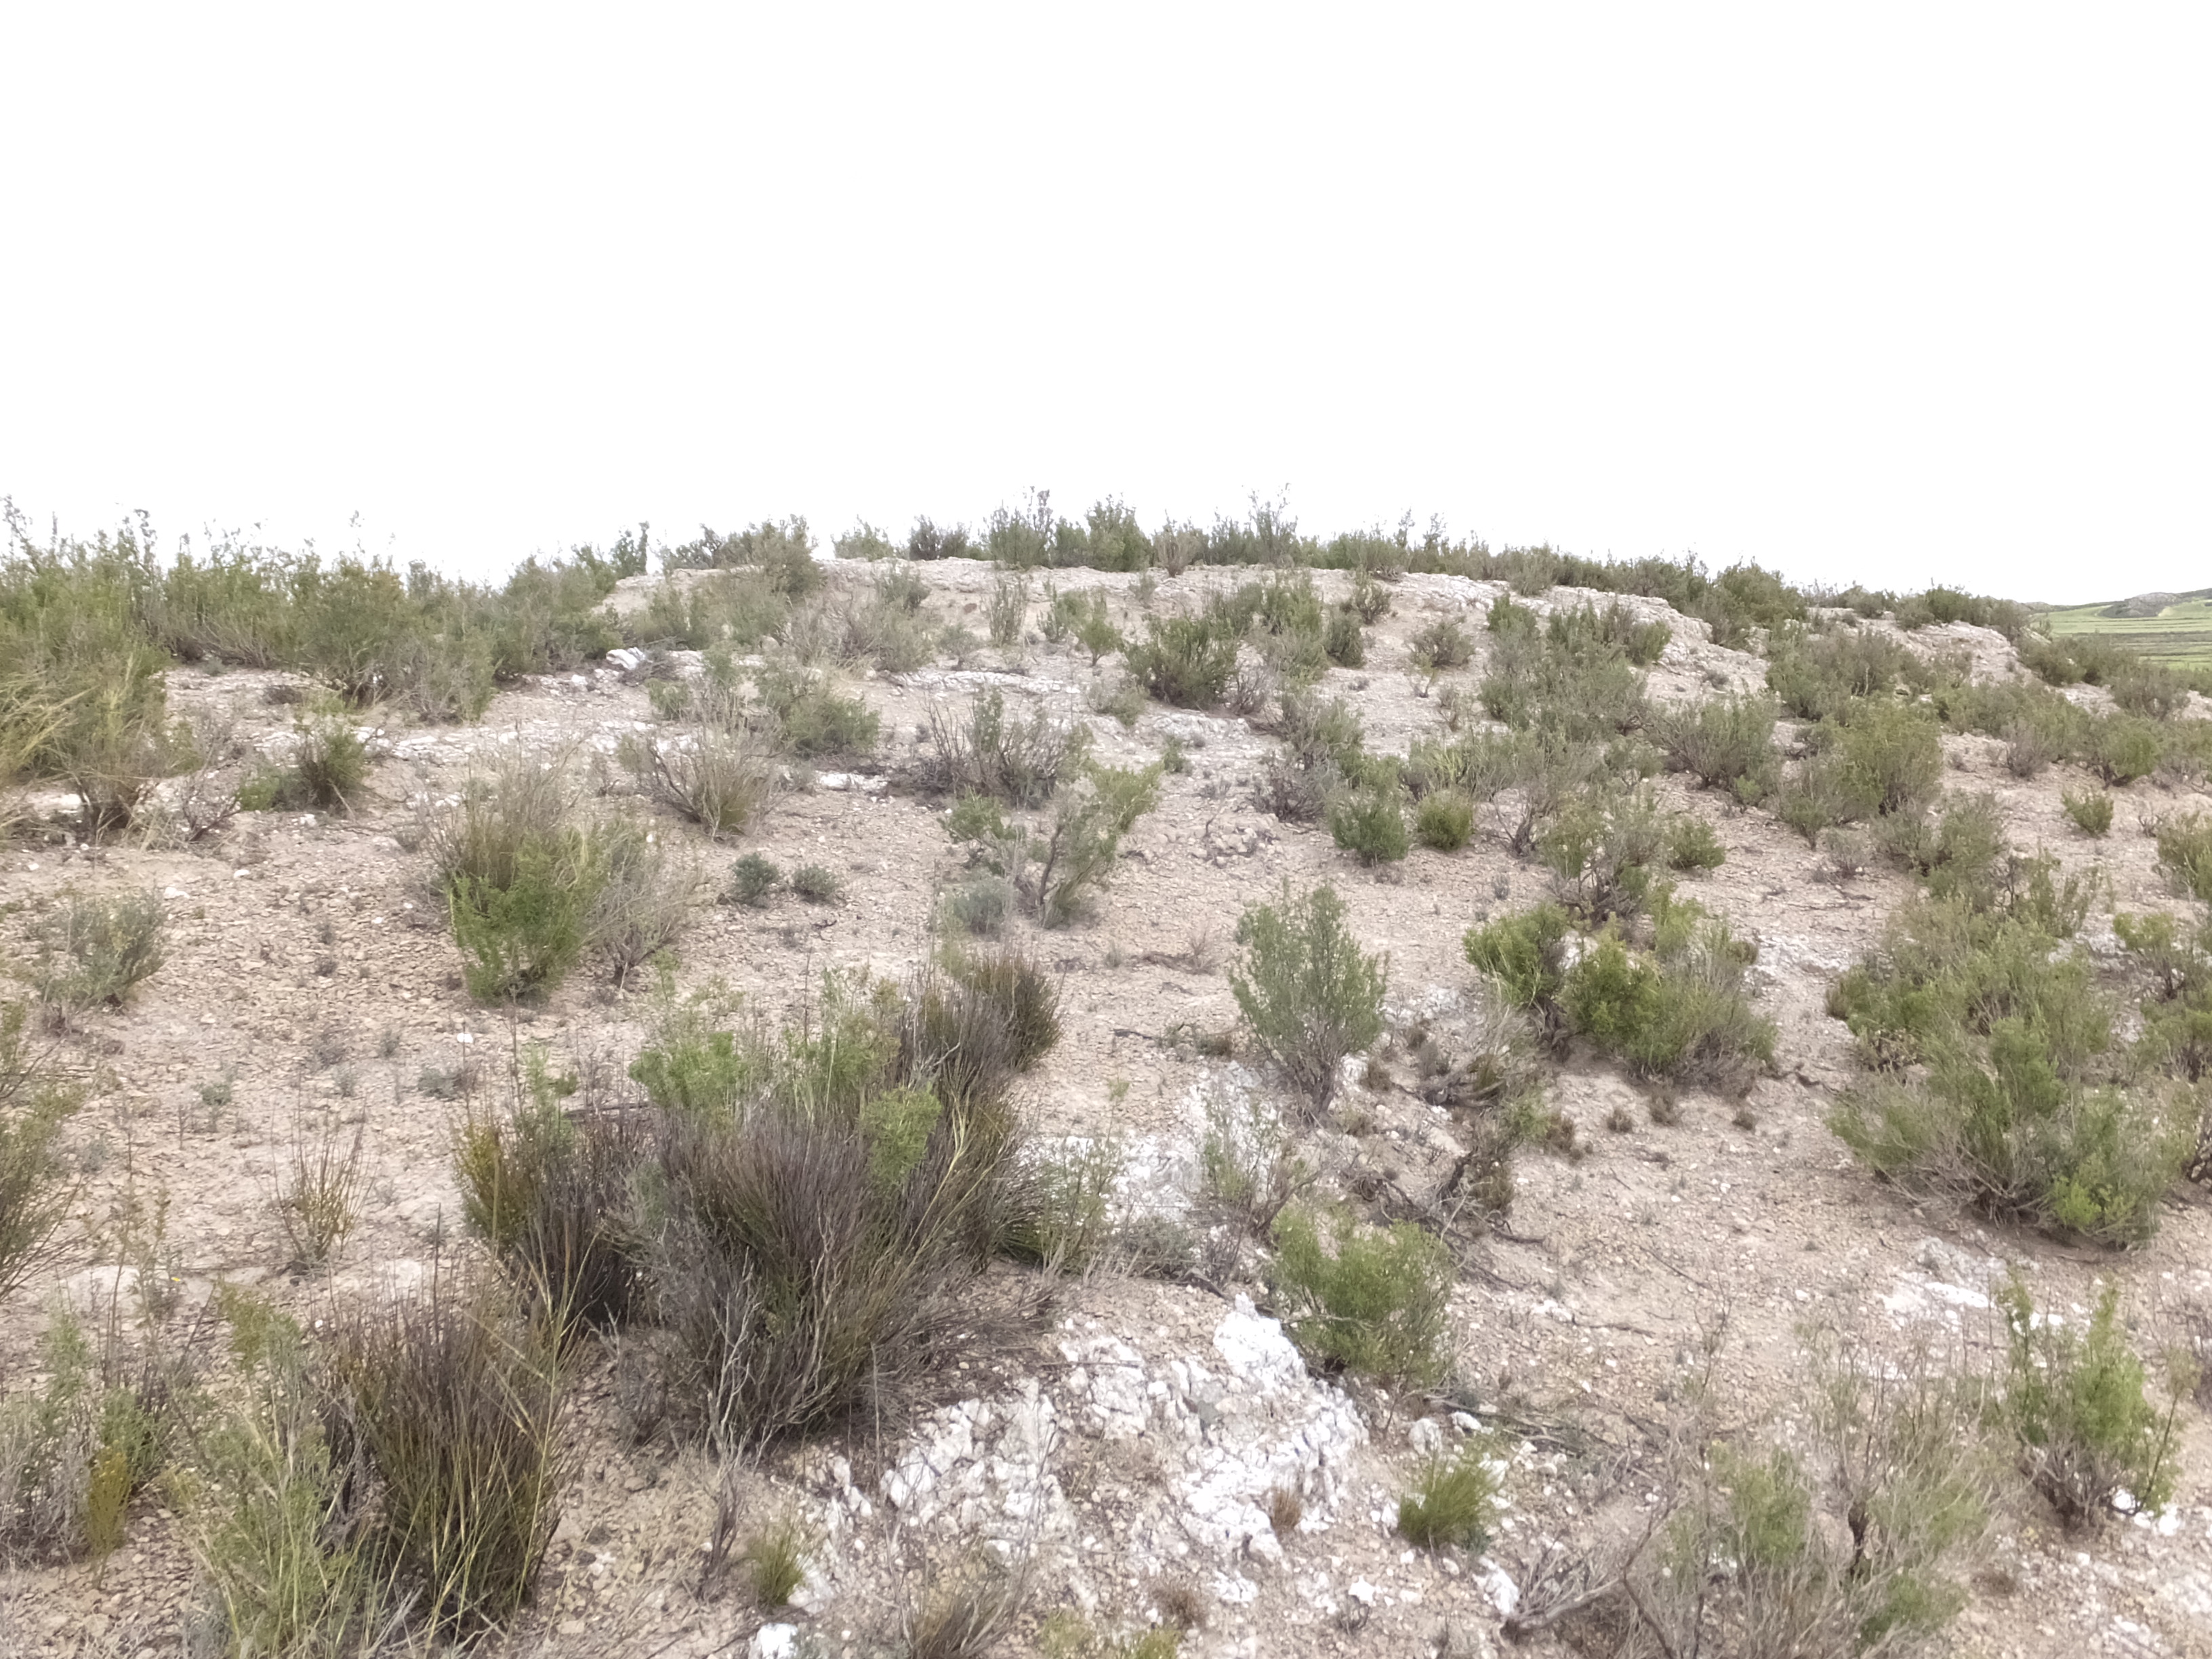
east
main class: Shrubland
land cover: Shrubland without tree cover
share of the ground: 25 - 50 %
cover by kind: shrubs 40 %, consolidated bare surface 35 %, herbaceous plants 25 %
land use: Semi-natural and natural areas not in use
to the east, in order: Shrubland without tree cover; Grass margins; Barley; Grass margins; Durum wheat; Shruby margins; Durum wheat; Shrubland without tree cover
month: May
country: ES
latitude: 41.4852
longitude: -0.3525
